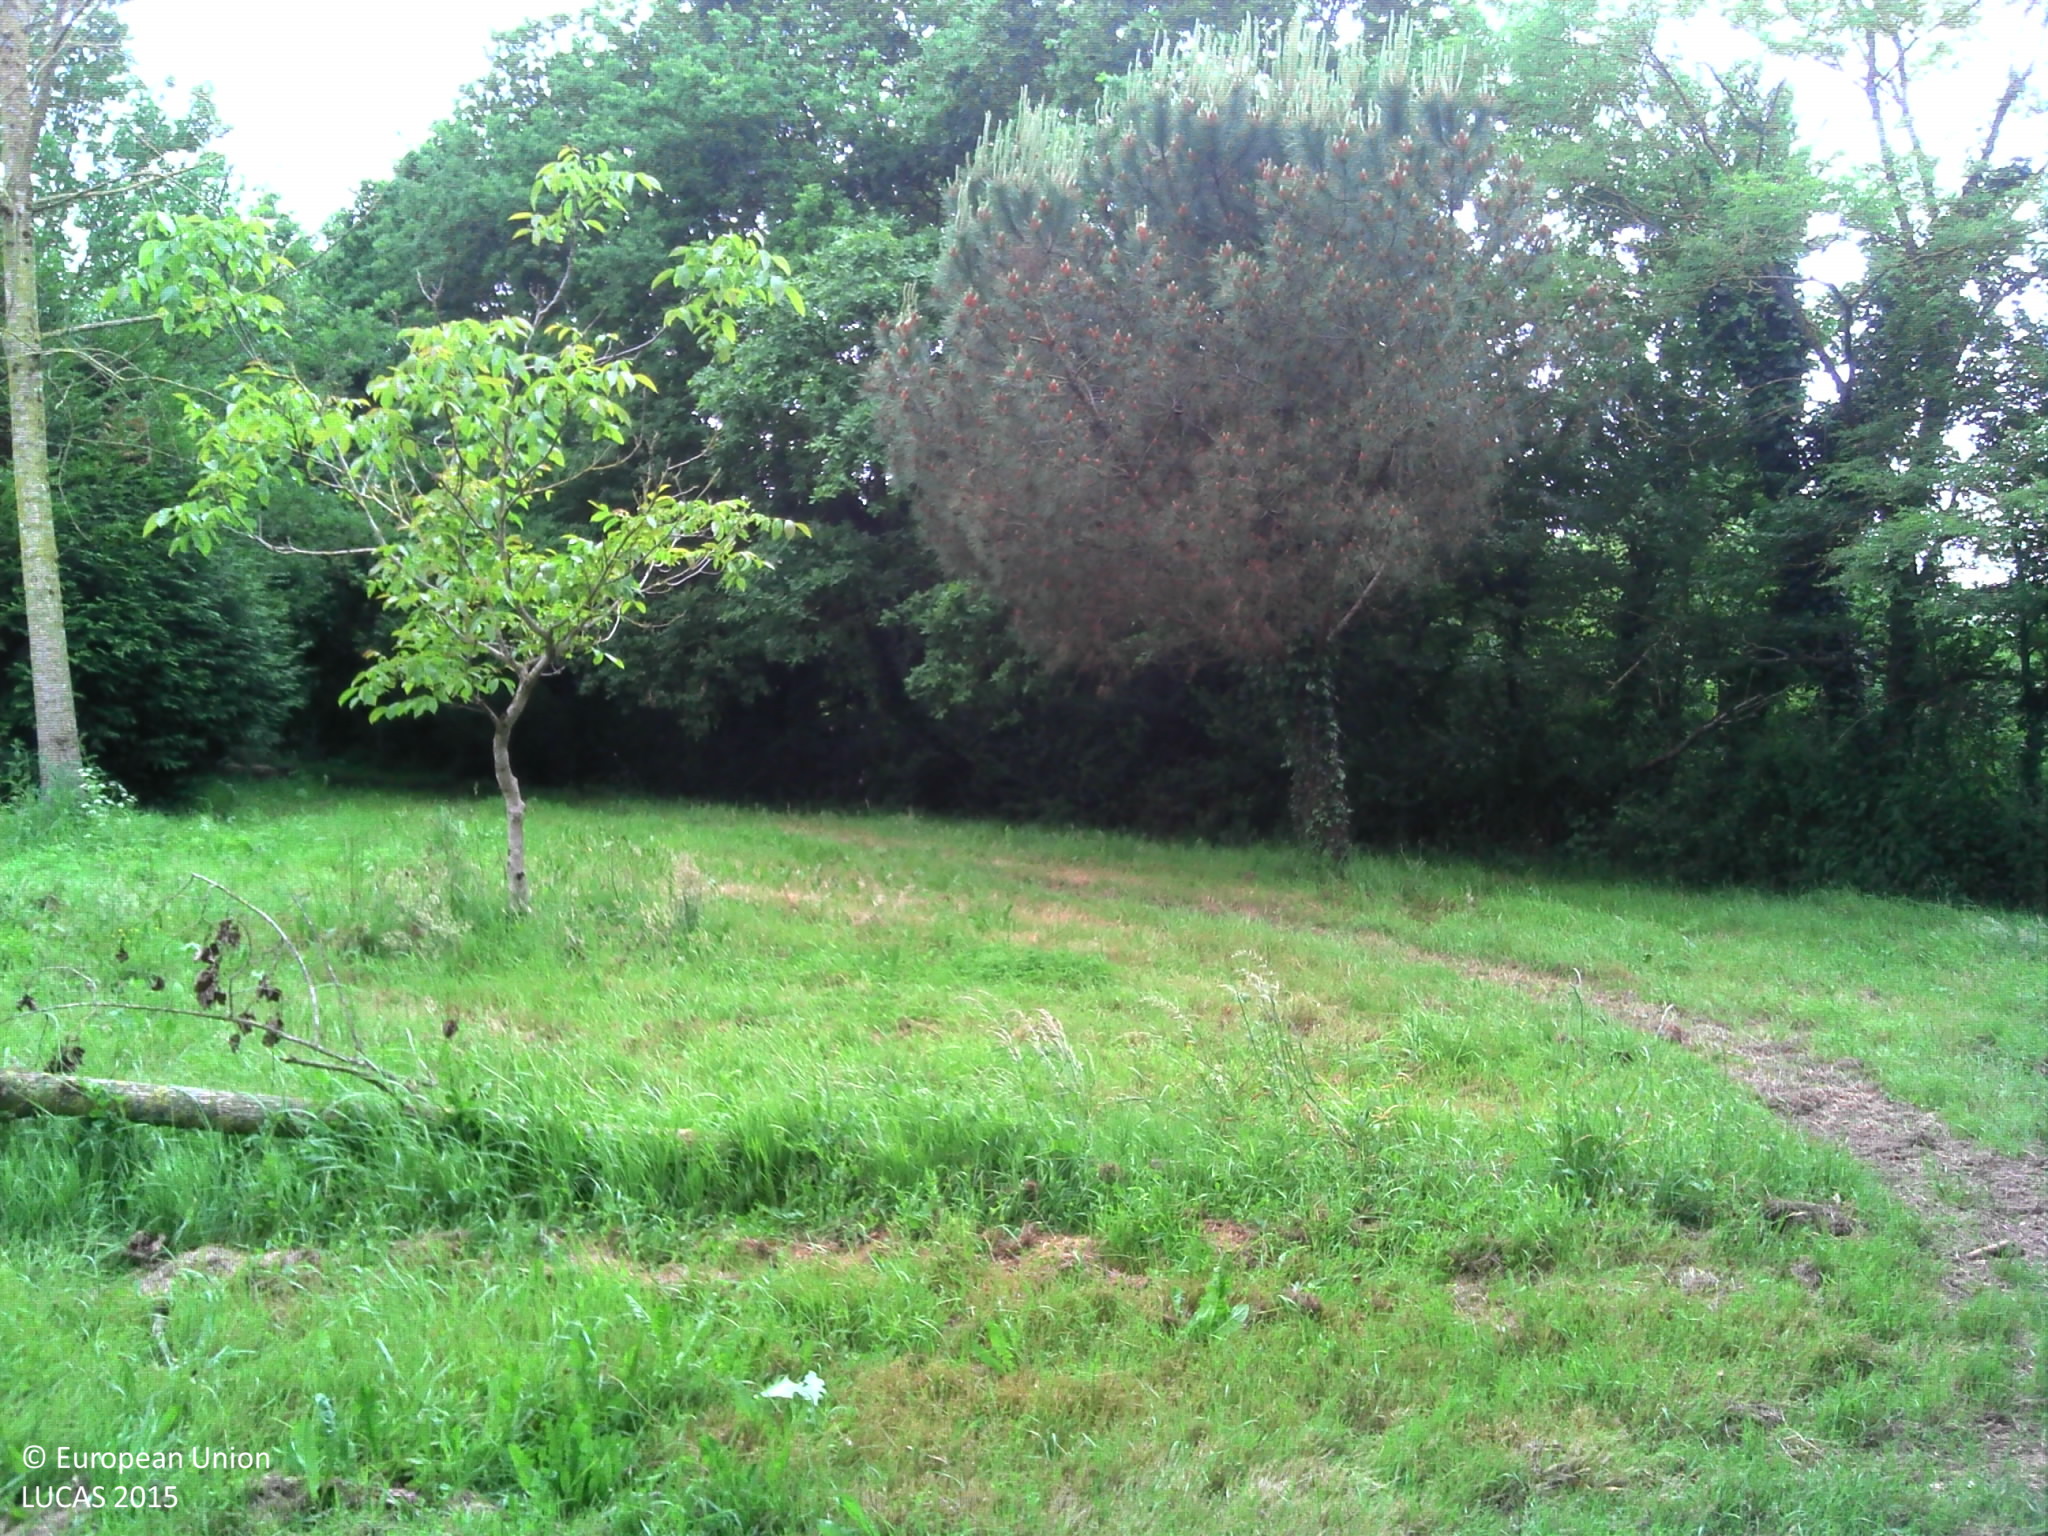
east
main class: Grassland
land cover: Grassland with sparse tree/shrub cover
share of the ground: > 75 %
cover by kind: herbaceous plants 95 %, broadleaved forest trees 5 %
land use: Residential
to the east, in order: Grassland with sparse tree/shrub cover; Artificial constructions in urban areas; Managed hedges; Other bare soil; Lines of trees; Ditches and canals; Artificial constructions in urban areas; Ditches and canals; Grass margins; Paved roads, cycling and walking lanes; Grass margins; Ditches and canals; Managed hedges; Maize
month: June
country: FR
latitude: 46.8439
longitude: -1.7794
